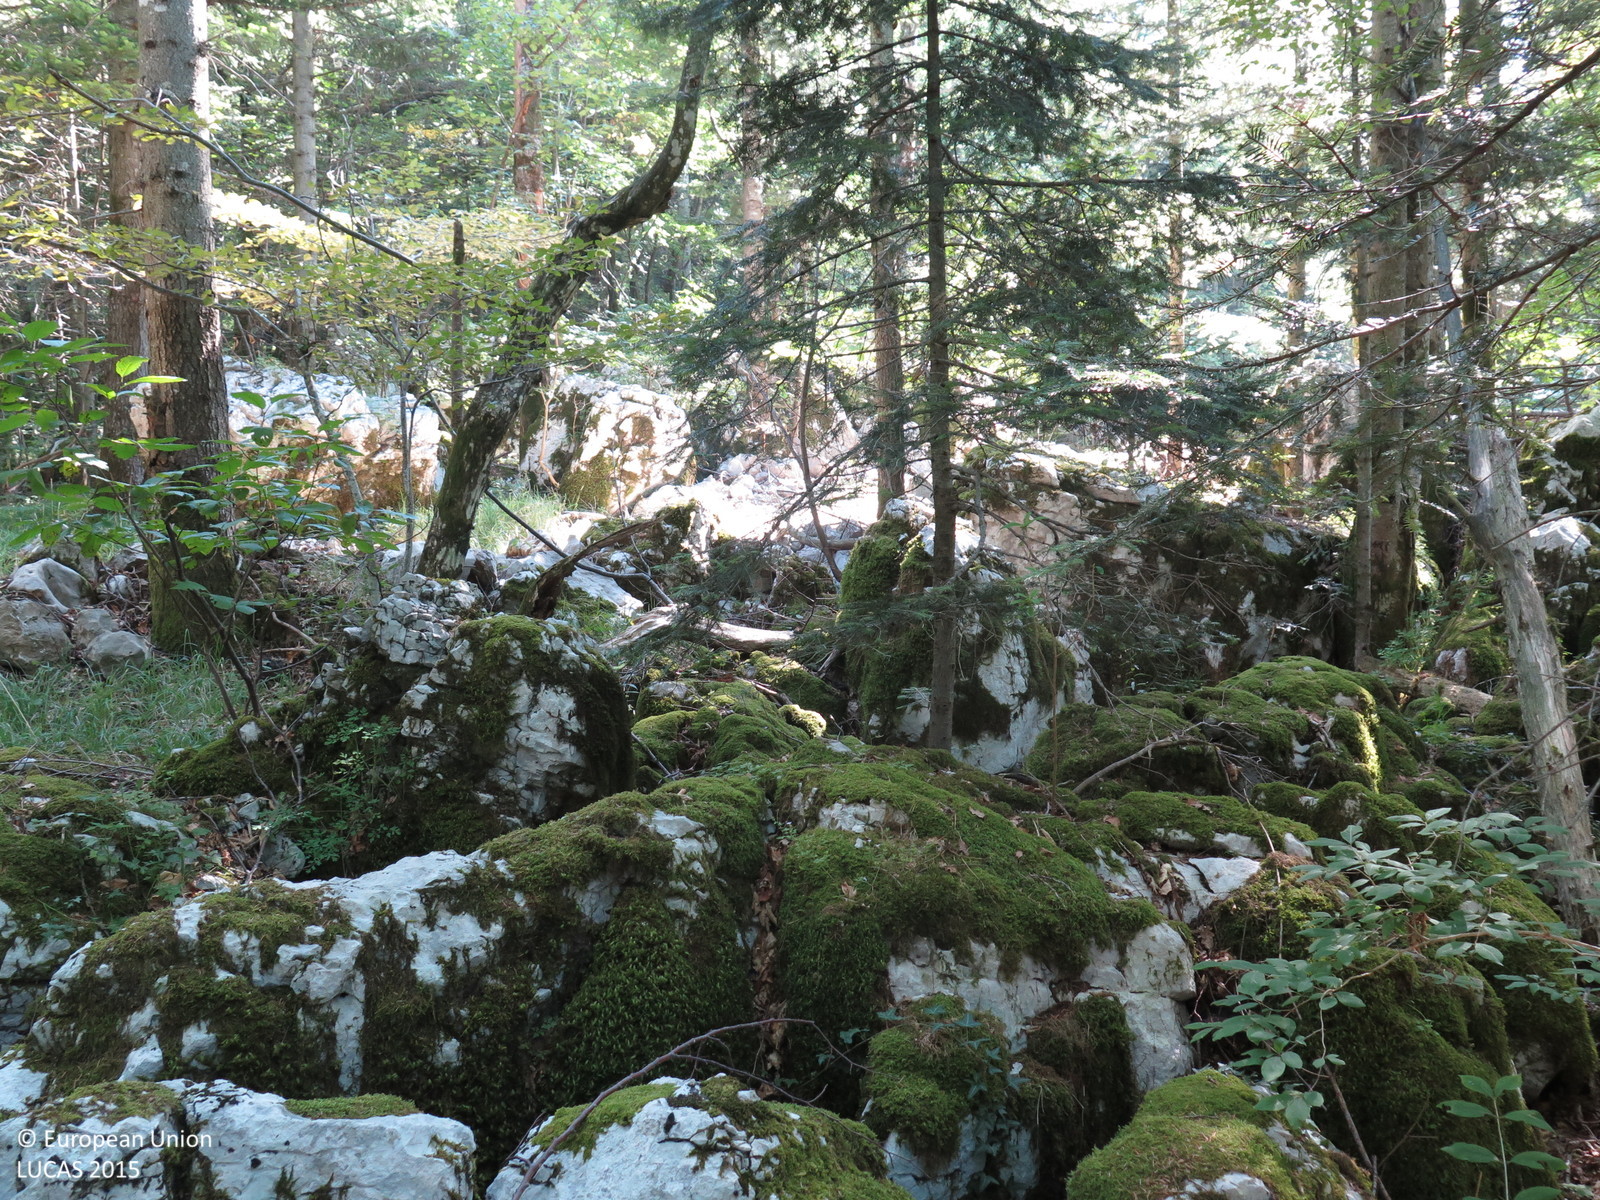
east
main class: Woodland
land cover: Other mixed woodland
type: mountainous beech forest
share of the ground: > 75 %
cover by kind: coniferous forest trees 75 %, broadleaved forest trees 25 %
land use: Forestry
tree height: > 5 m
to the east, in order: Other mixed woodland; Rocks and stones; Other mixed woodland; Rocks and stones
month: August
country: HR
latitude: 45.1981
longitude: 14.7684
